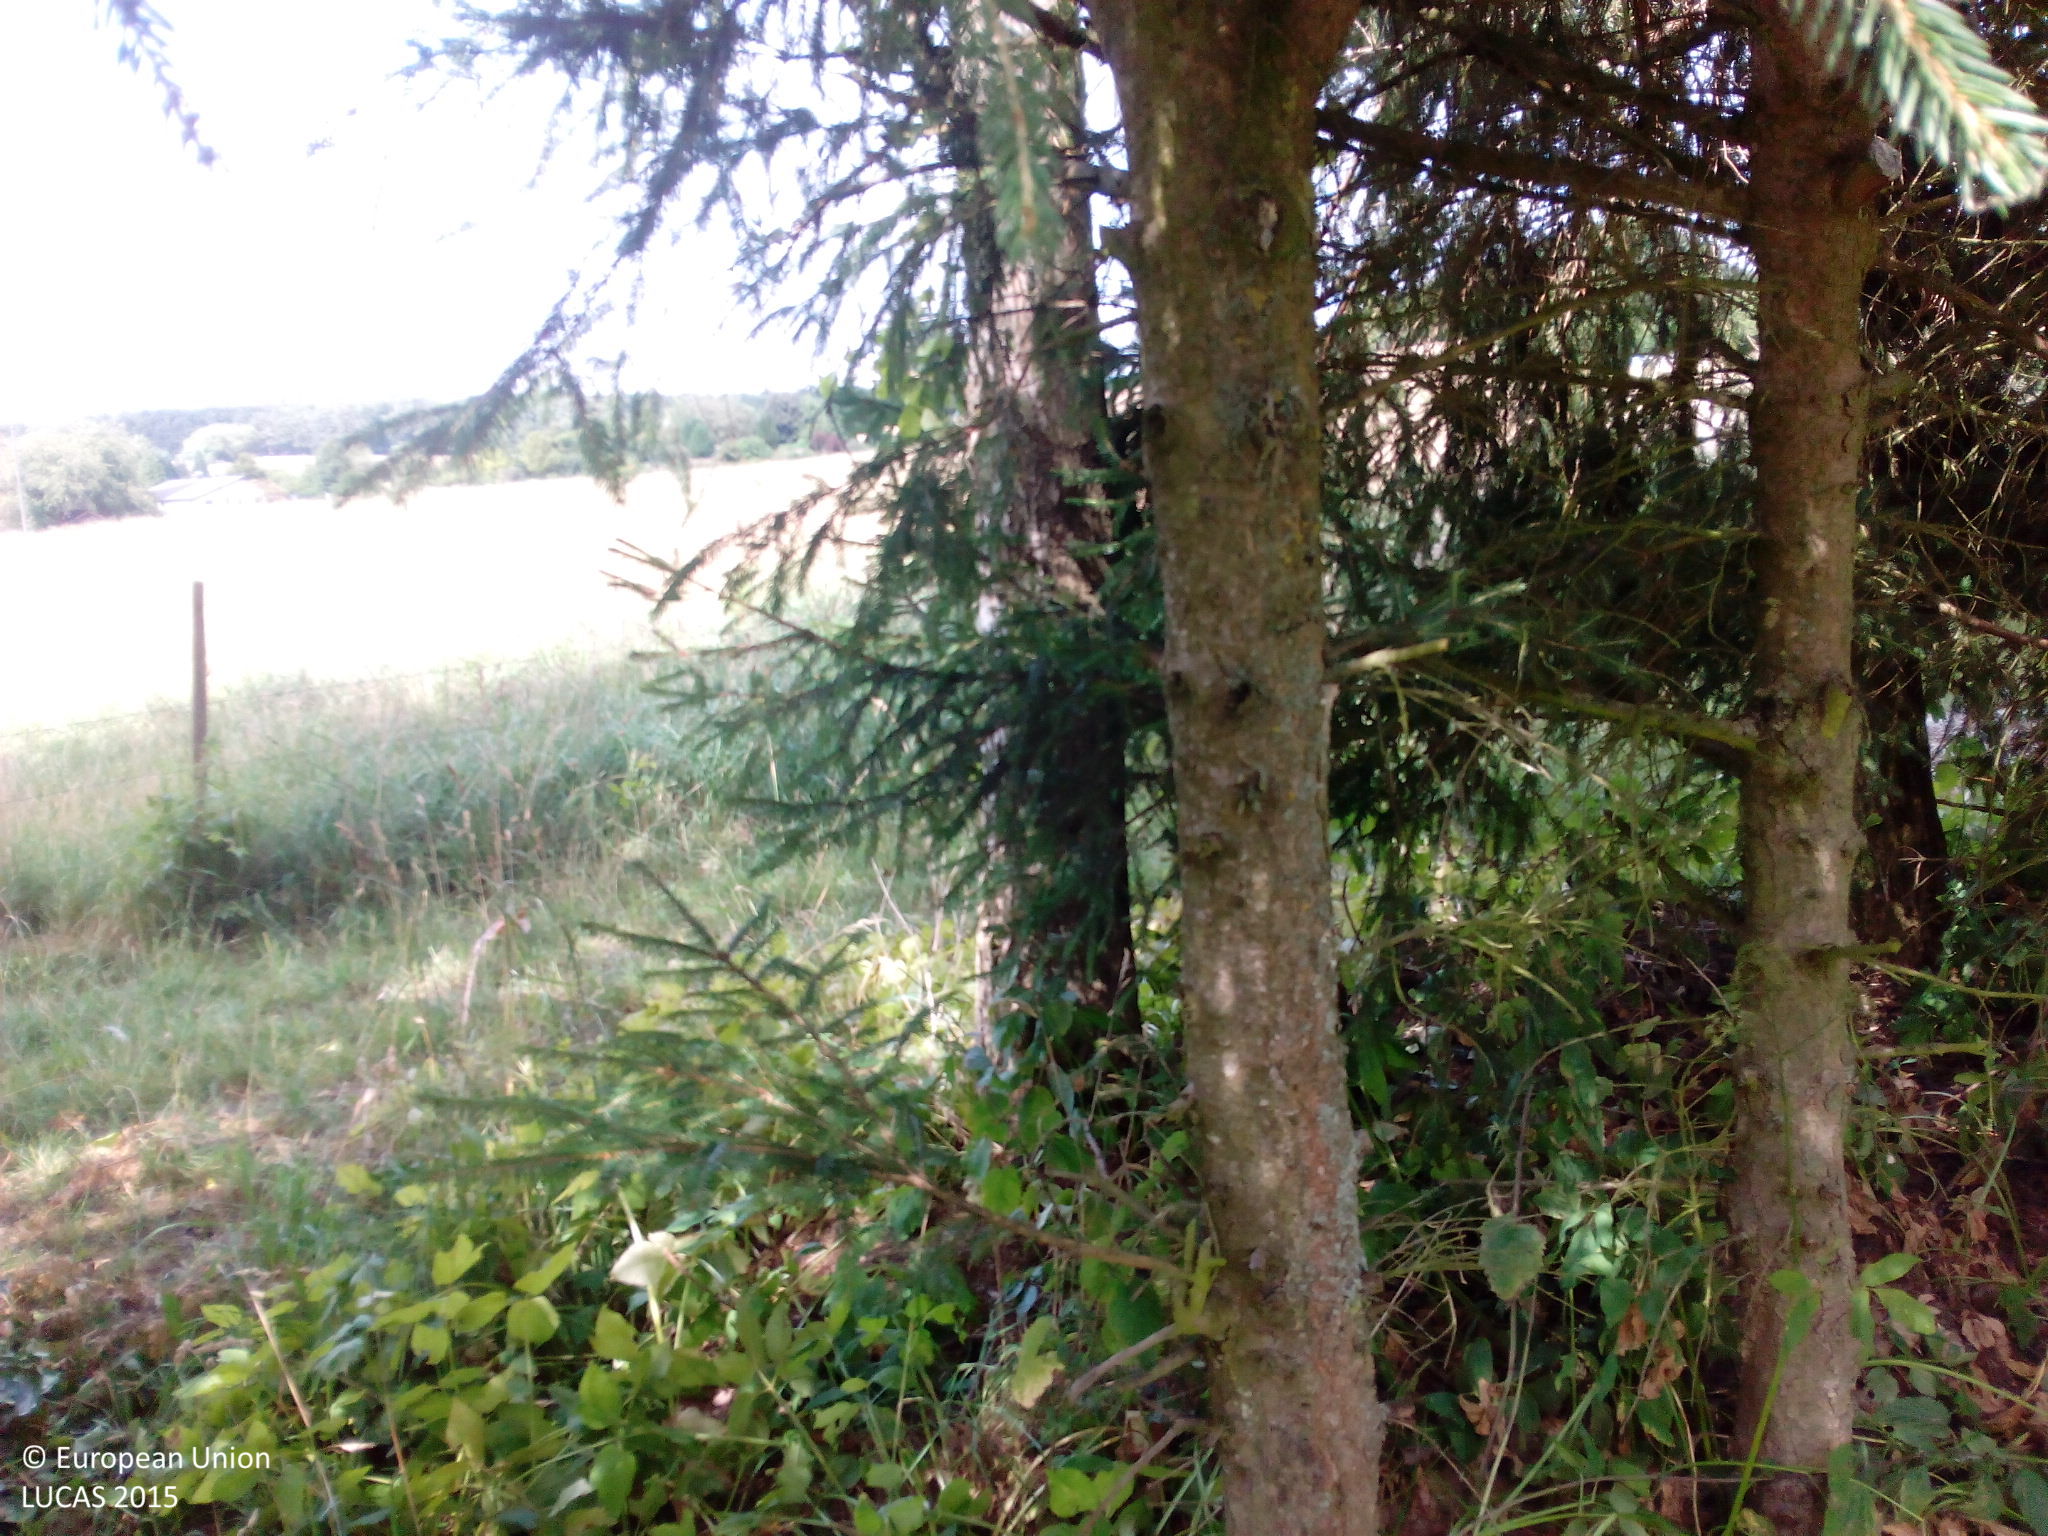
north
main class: Grassland
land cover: Grassland with sparse tree/shrub cover
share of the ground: > 75 %
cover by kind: herbaceous plants 95 %, broadleaved forest trees 5 %
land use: Residential
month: July
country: DE
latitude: 49.8600
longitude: 7.1207
